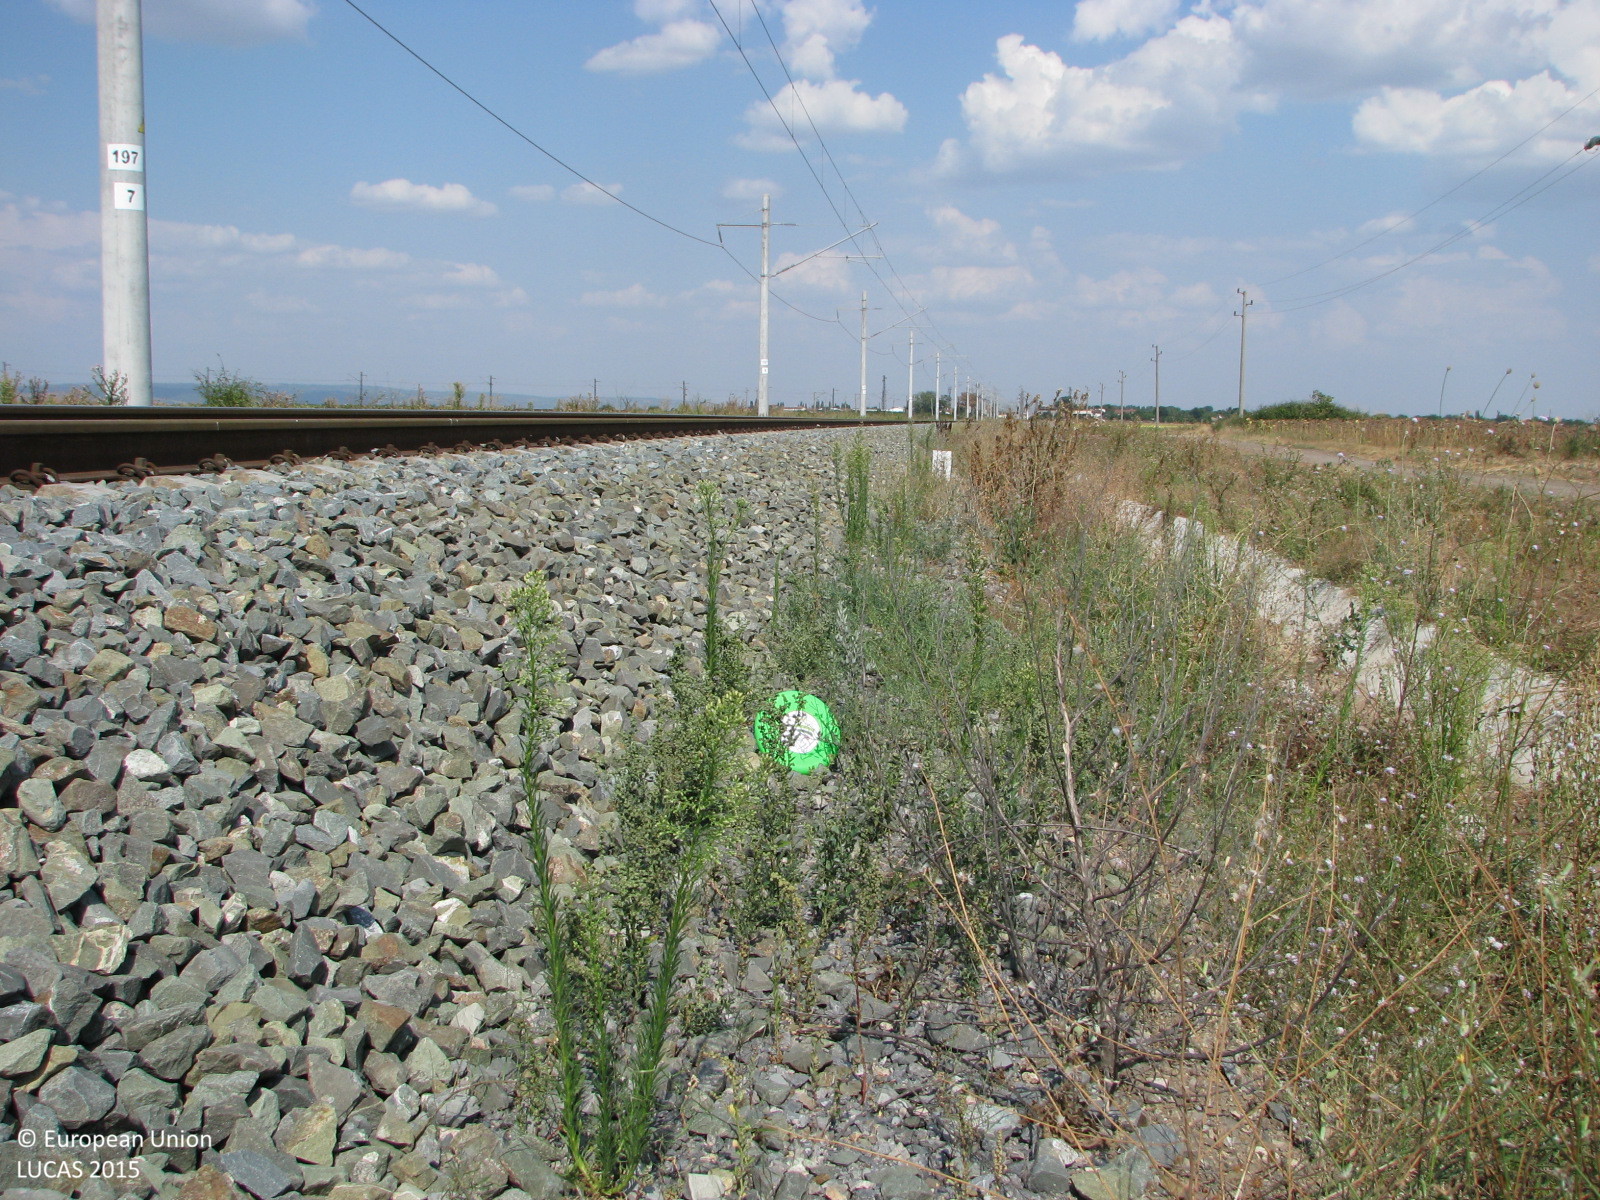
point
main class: Grassland
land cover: Spontaneously vegetated surfaces
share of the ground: > 75 %
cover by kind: herbaceous plants 100 %
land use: Railway transport
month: August
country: BG
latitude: 42.5823
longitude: 26.5810
